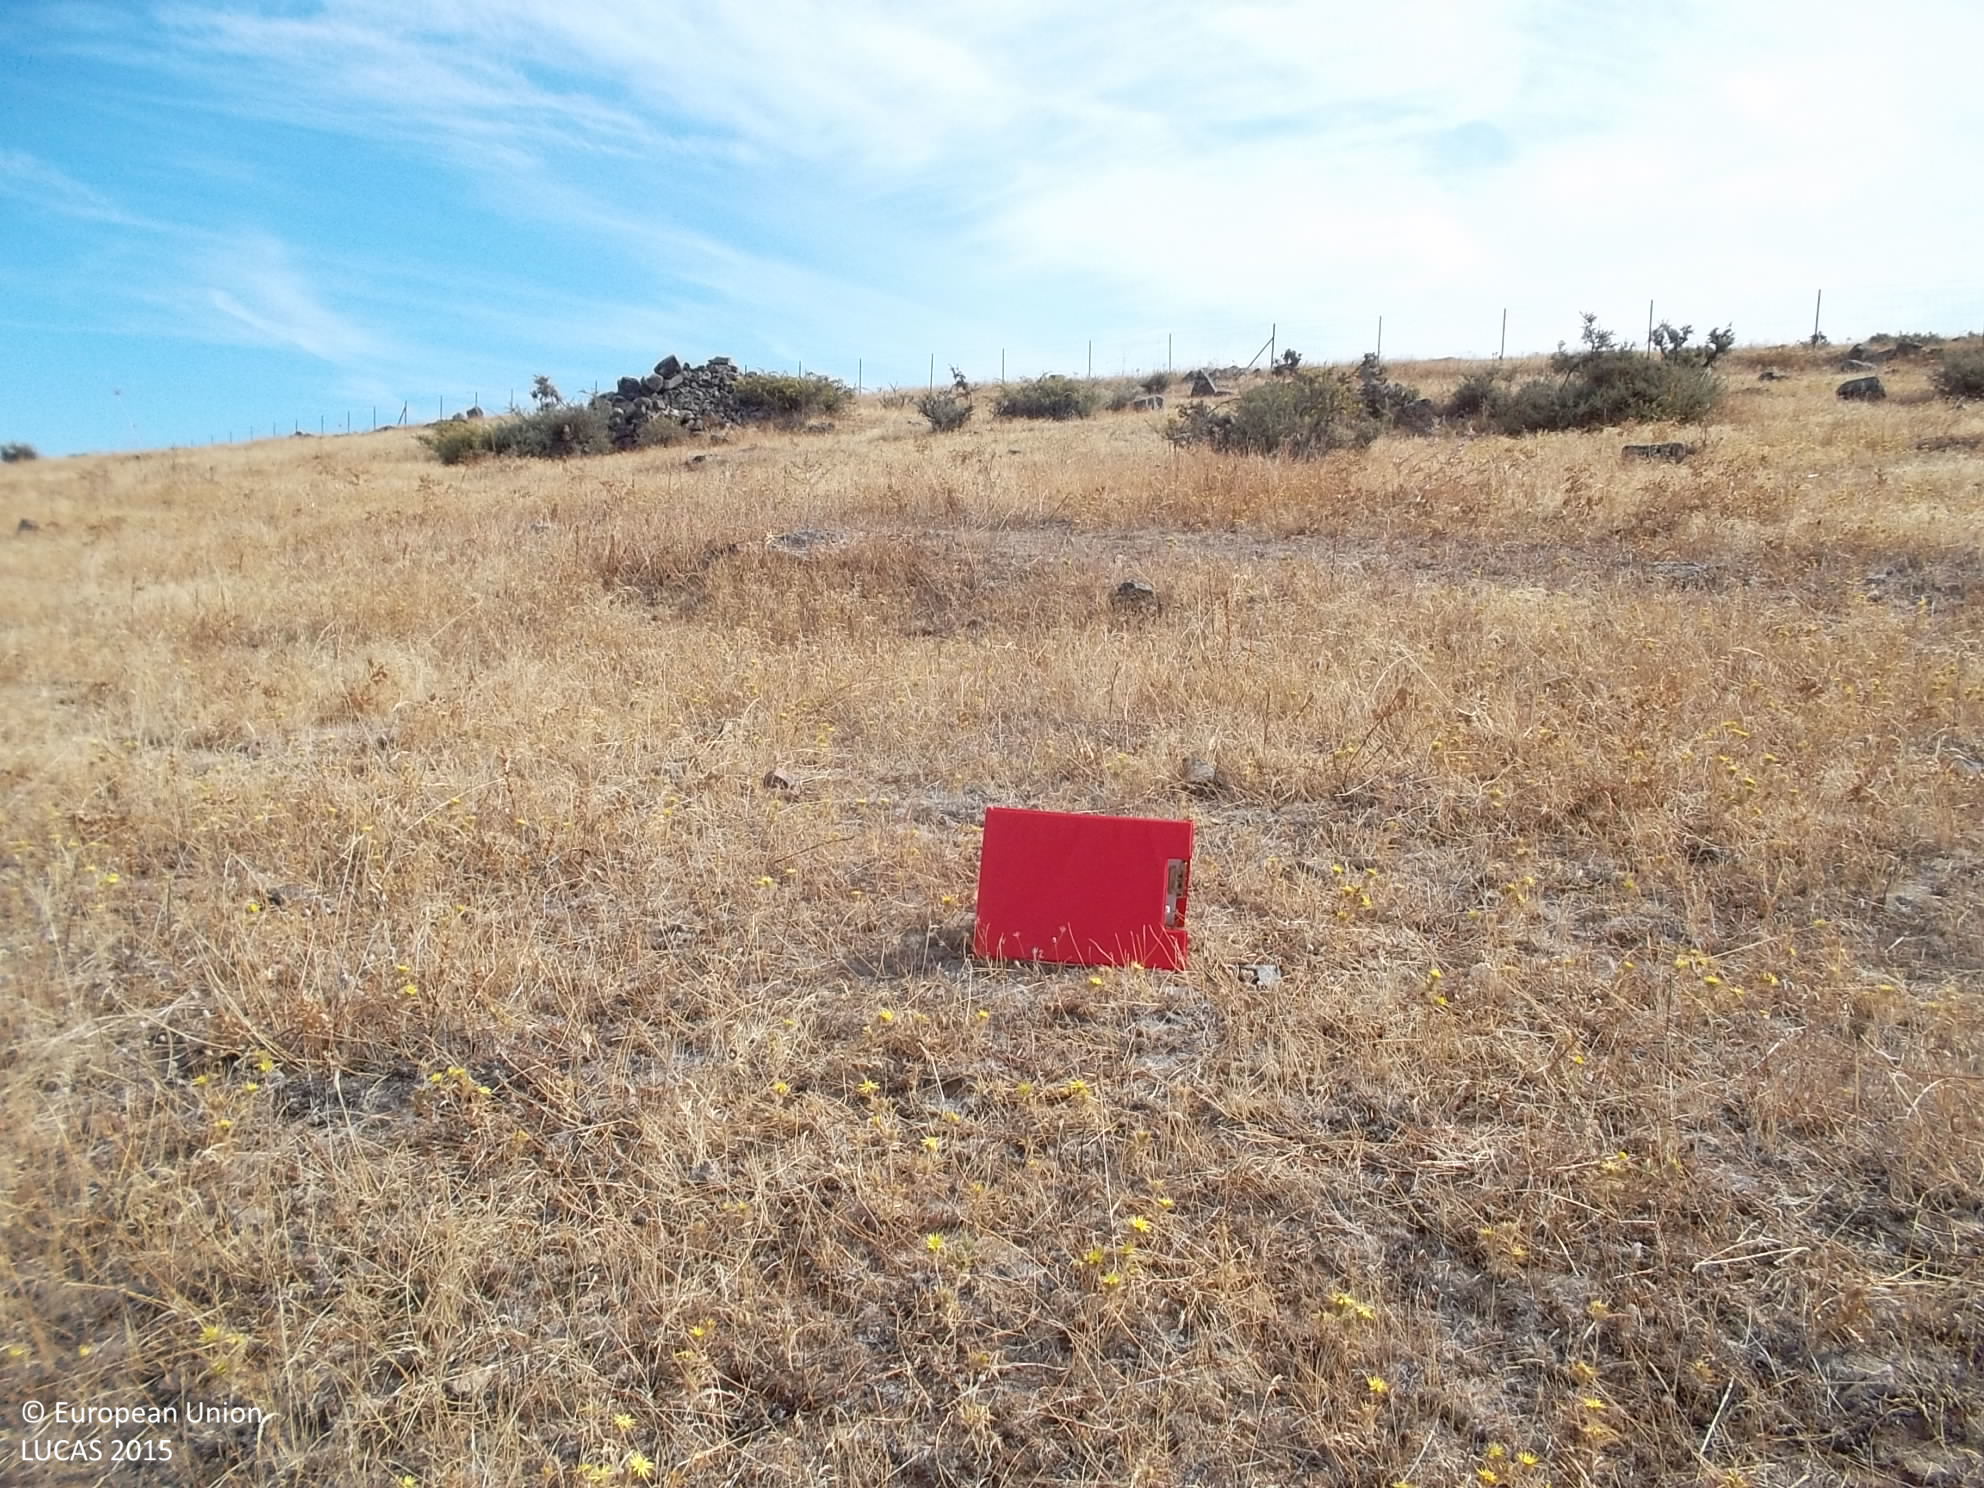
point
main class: Grassland
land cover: Grassland without tree/shrub cover
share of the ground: > 75 %
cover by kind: herbaceous plants 100 %
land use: Agriculture (excluding fallow land and kitchen gardens)
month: August
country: ES
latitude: 38.1583
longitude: -6.6089
